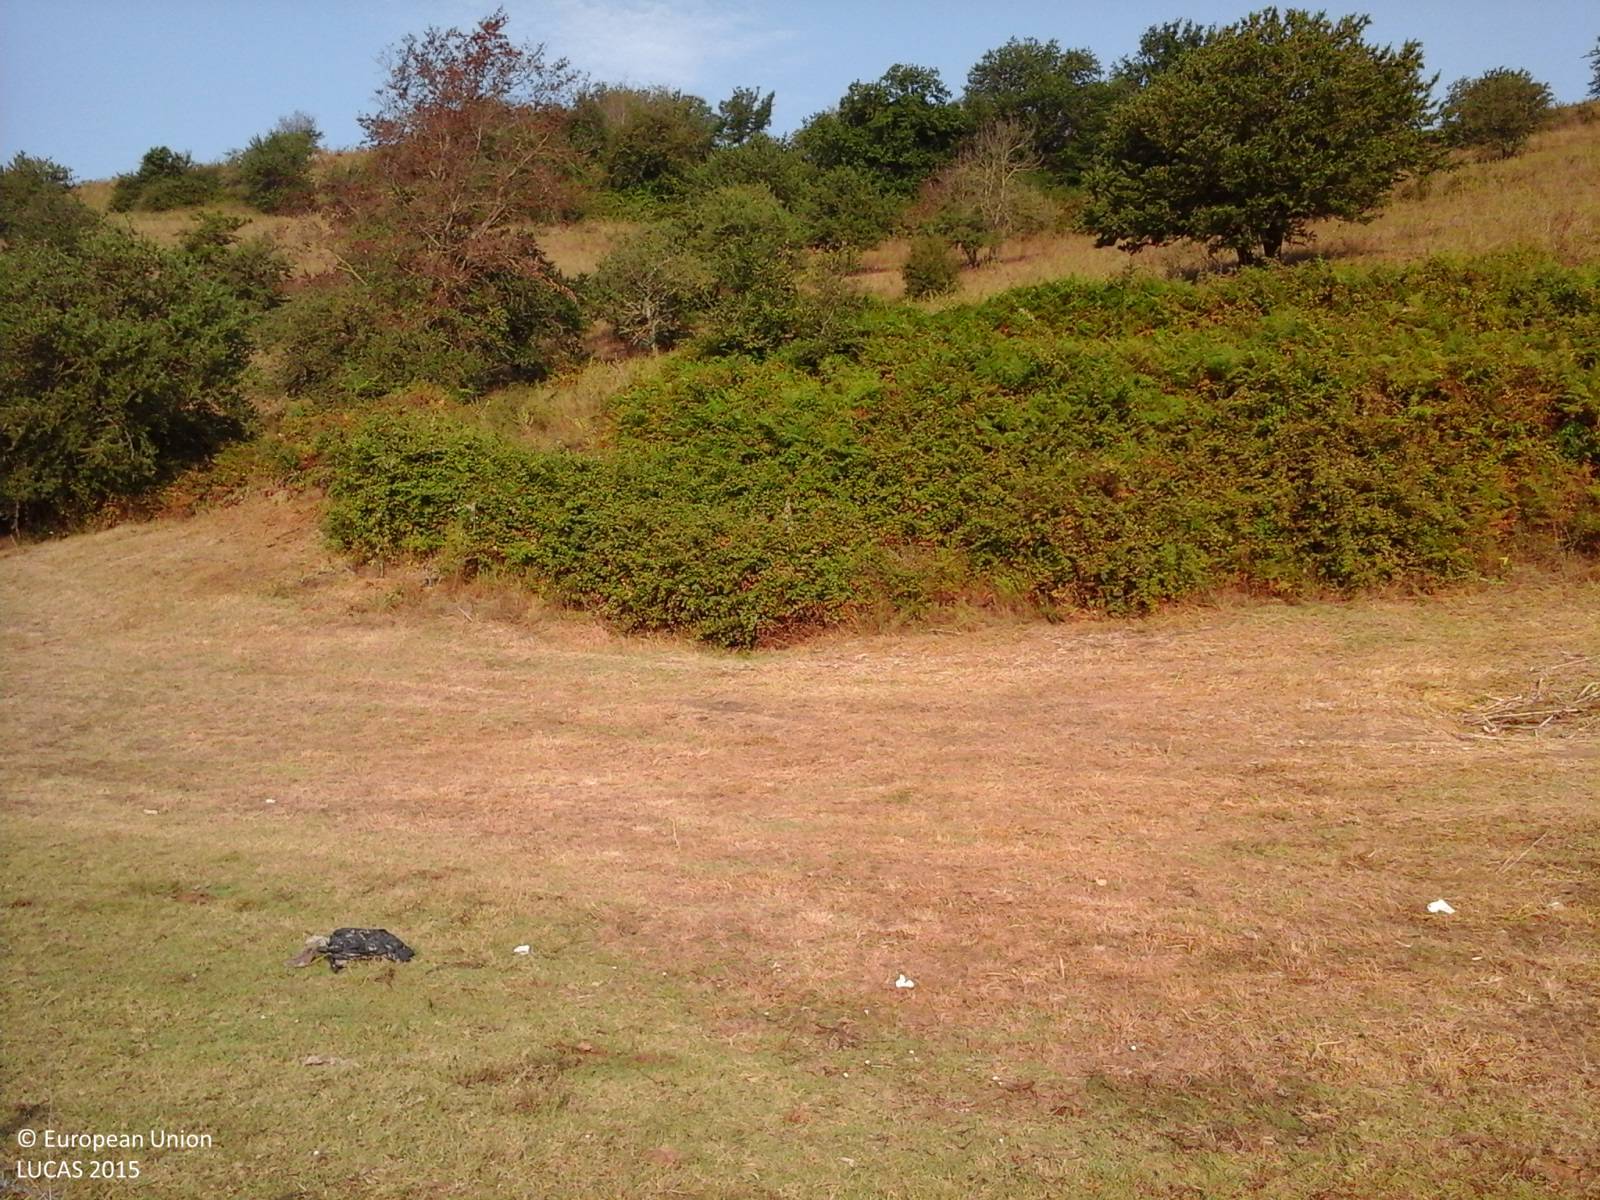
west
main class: Grassland
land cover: Grassland without tree/shrub cover
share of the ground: > 75 %
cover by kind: herbaceous plants 100 %
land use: Agriculture (excluding fallow land and kitchen gardens)
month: July
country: IT
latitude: 41.9237
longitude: 12.2705
